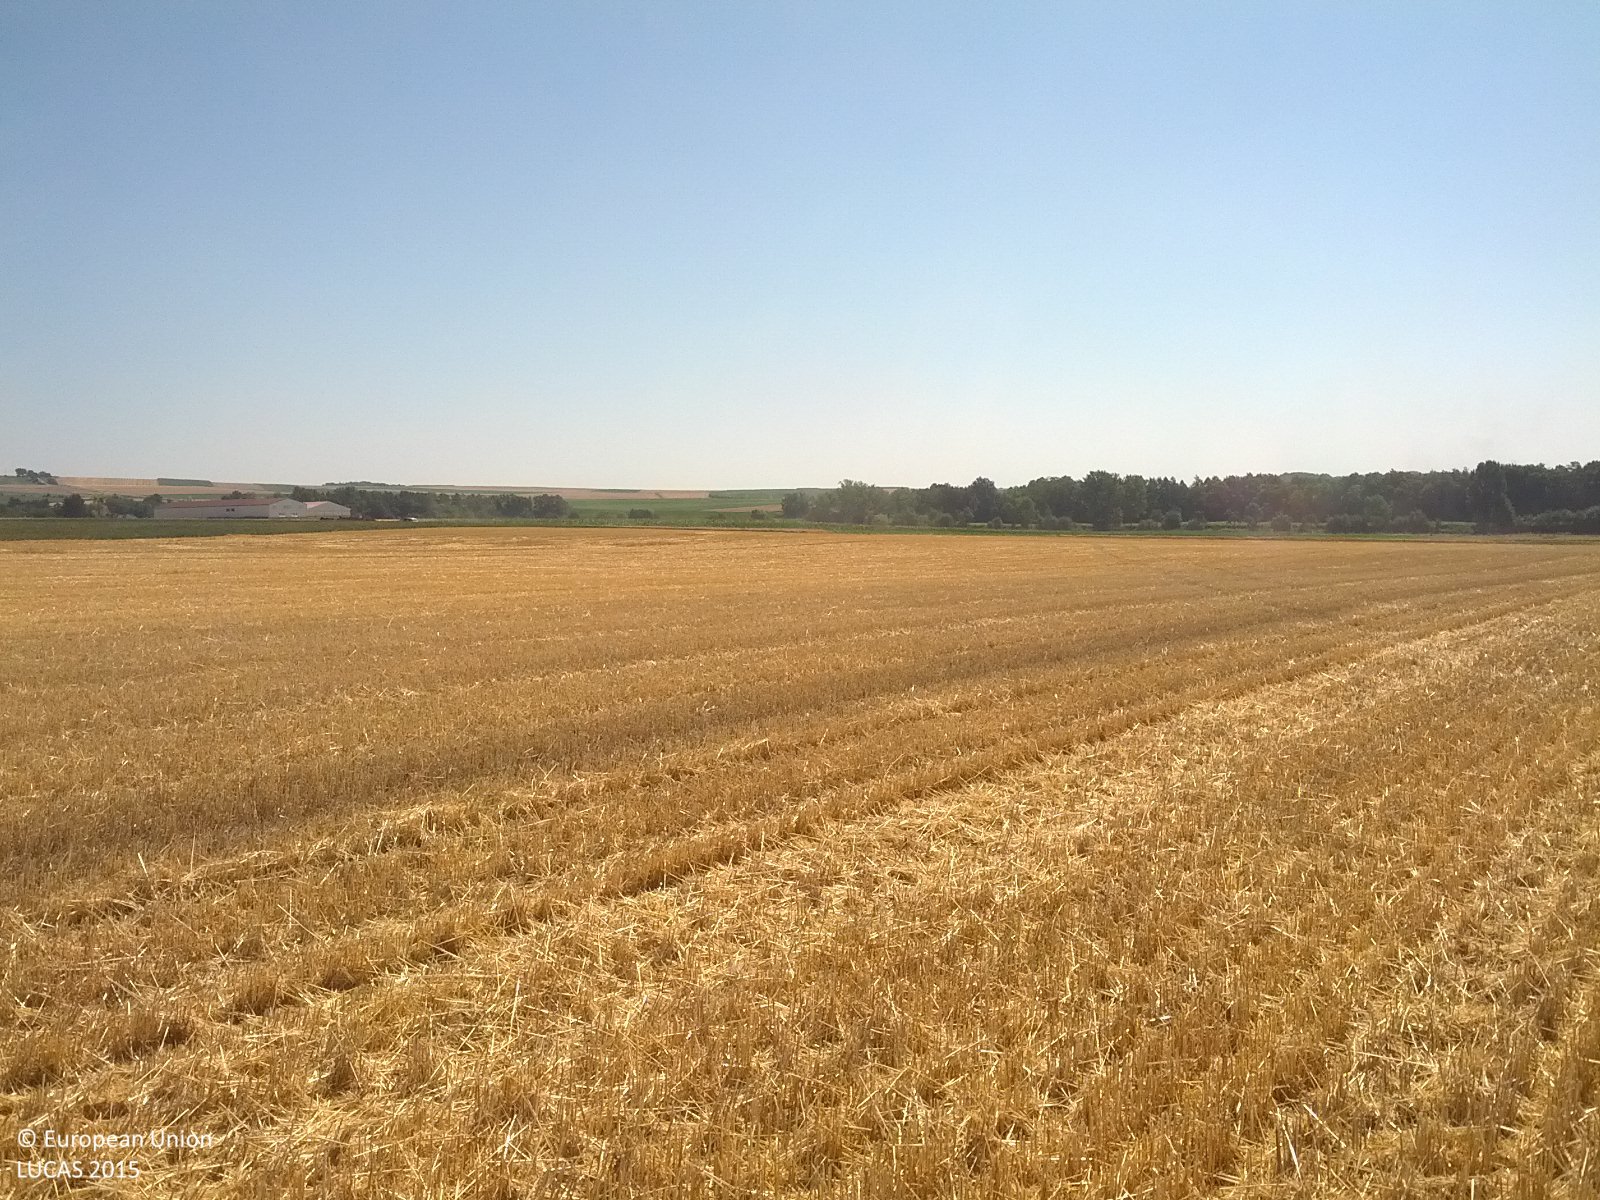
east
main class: Cropland
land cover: Common wheat
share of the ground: > 75 %
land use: Agriculture (excluding fallow land and kitchen gardens)
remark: Harvested field
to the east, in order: Common wheat; Grass margins; Tracks; Grass margins; Common wheat; Sugar beet
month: July
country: AT
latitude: 48.4843
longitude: 16.1607
